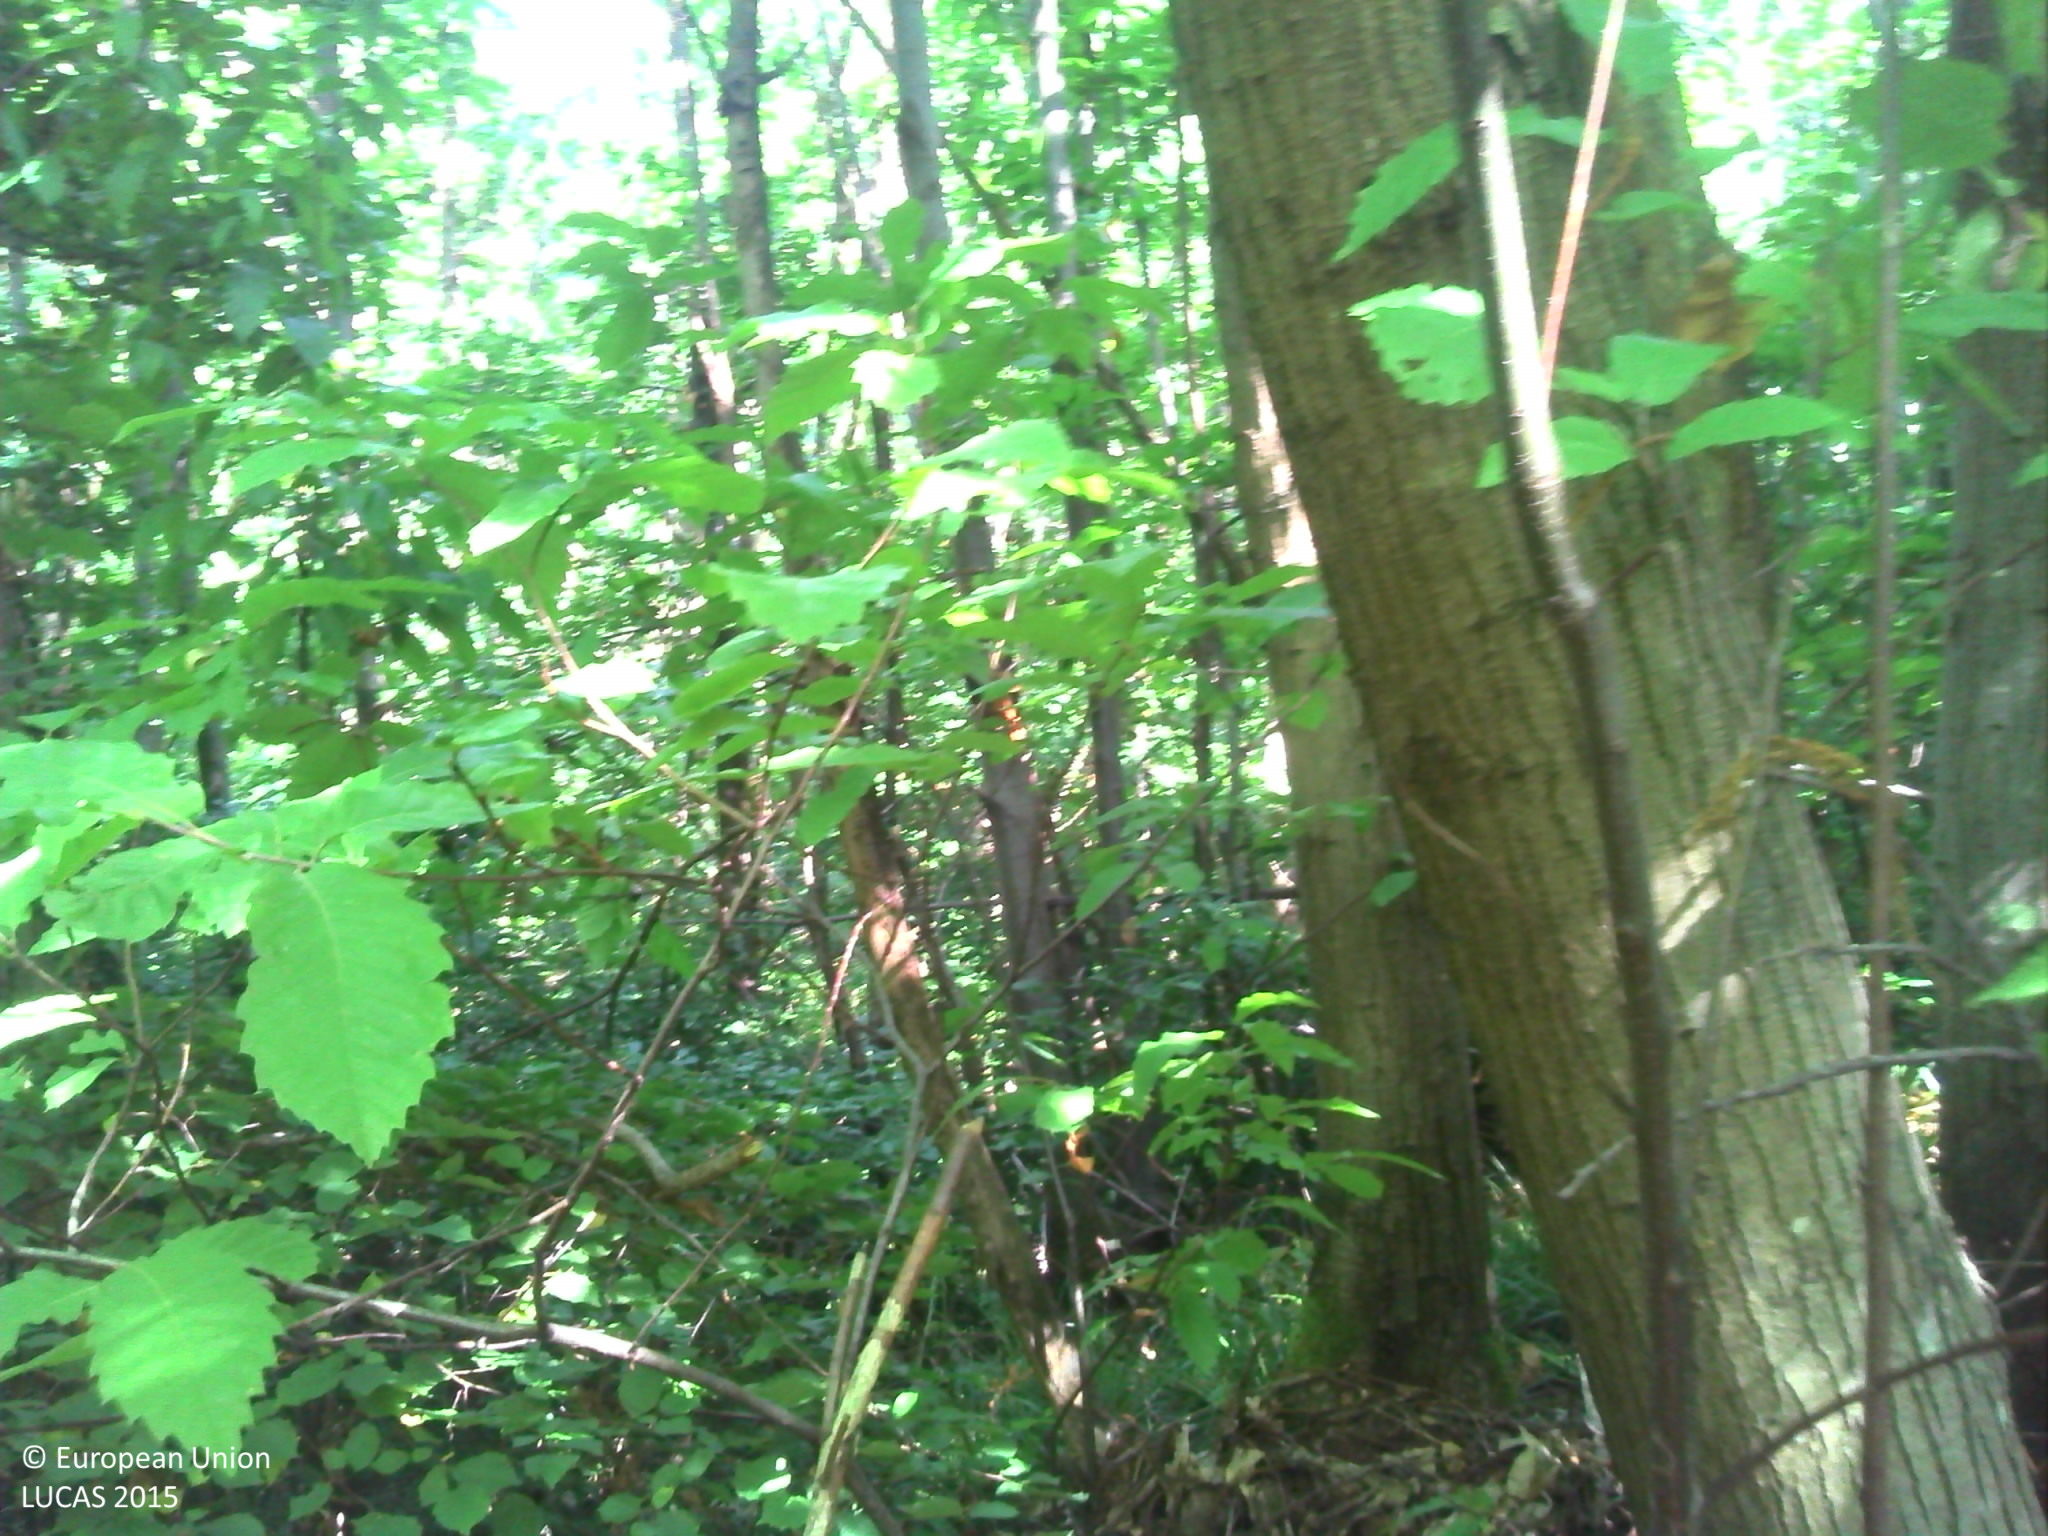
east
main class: Woodland
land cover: Broadleaved woodland
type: mesophytic deciduous forest
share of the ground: > 75 %
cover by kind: broadleaved forest trees 90 %, herbaceous plants 10 %
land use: Forestry
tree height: > 5 m
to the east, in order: Broadleaved woodland; Tracks; Broadleaved woodland; Tracks; Electric lines; Broadleaved woodland
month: August
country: FR
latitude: 45.6177
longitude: 4.9384
